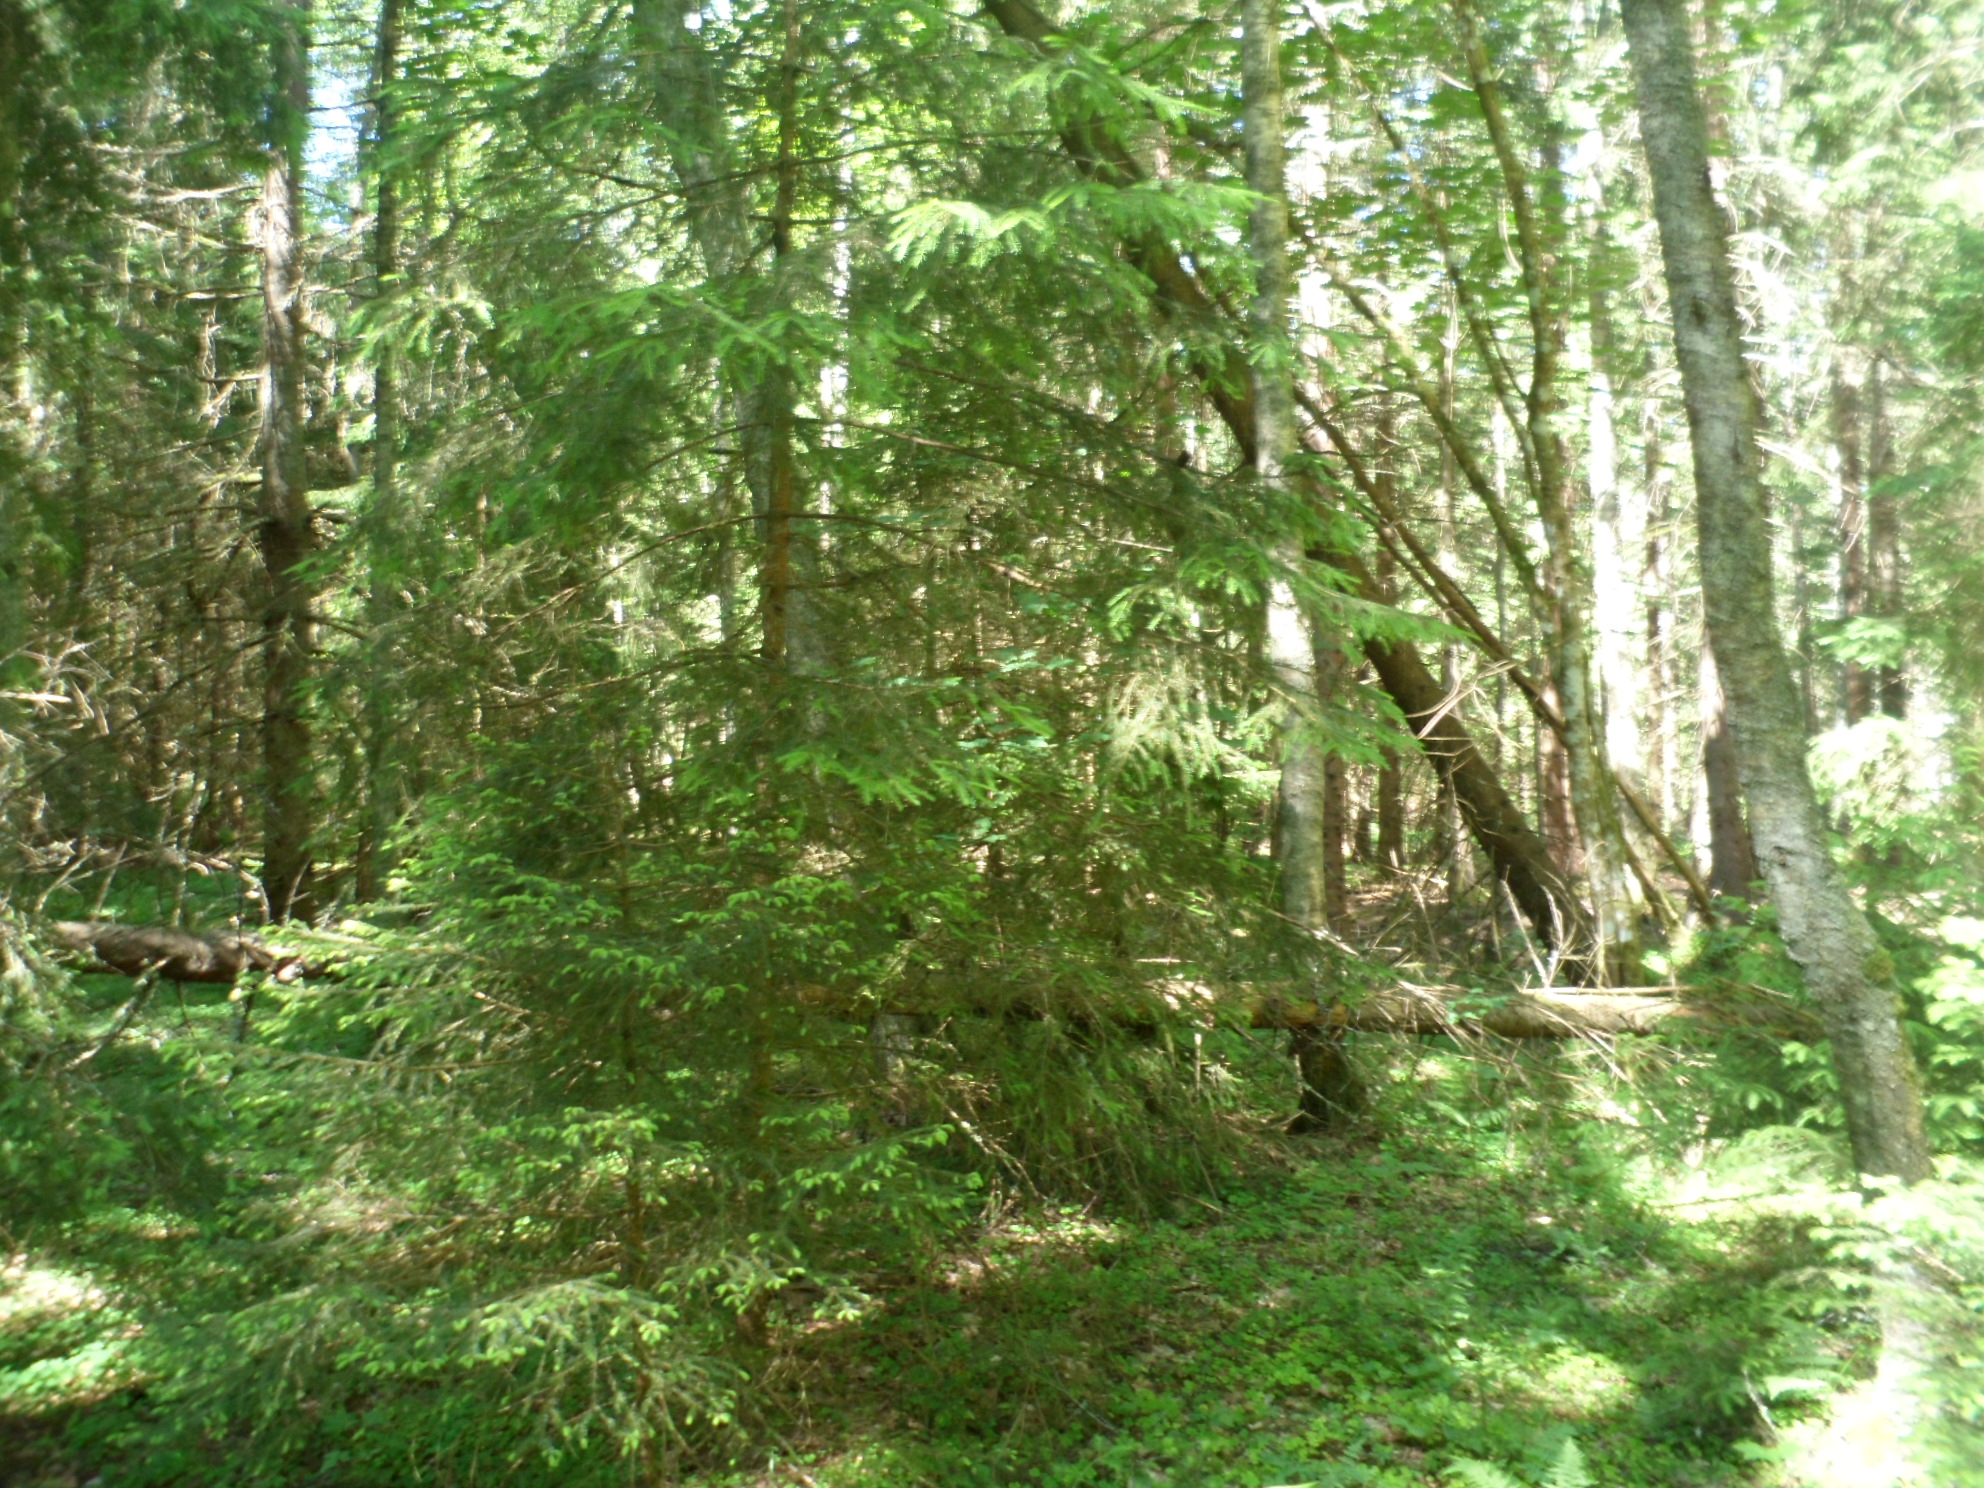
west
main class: Woodland
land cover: Spruce dominated mixed woodland
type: boreal forest
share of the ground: 50 - 75 %
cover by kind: coniferous forest trees 45 %, broadleaved forest trees 30 %, herbaceous plants 10 %, lichens and mosses 10 %, shrubs 5 %
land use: Forestry
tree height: > 5 m
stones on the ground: < 10 %
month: July
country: SE
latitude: 57.0814
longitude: 14.5006
